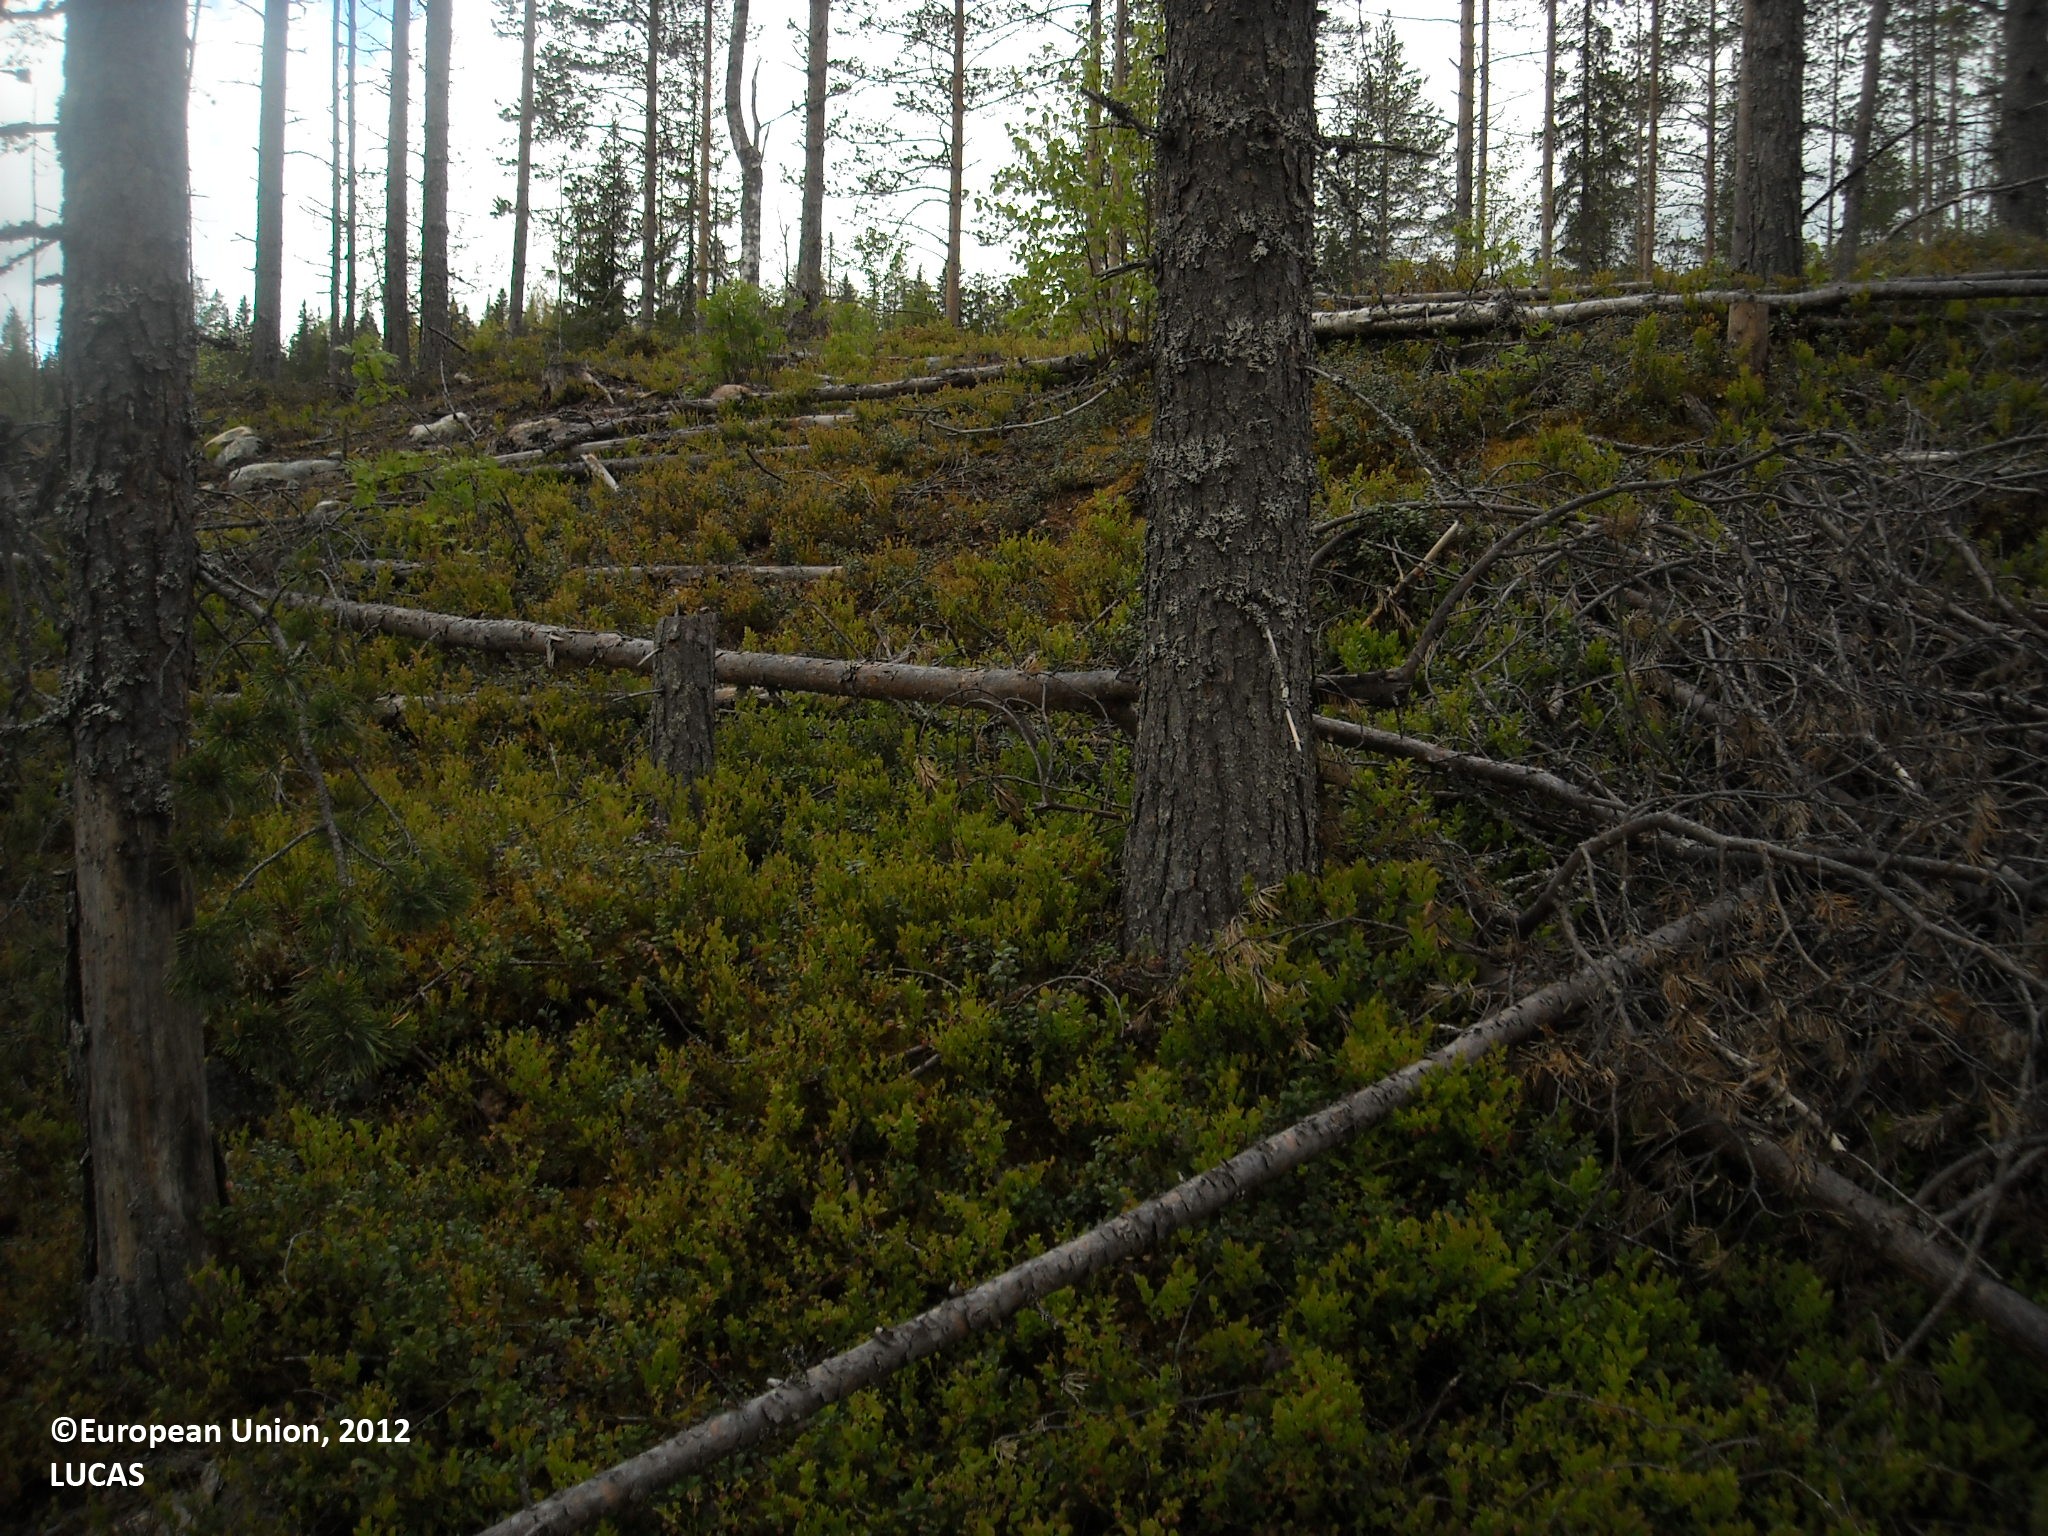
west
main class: Woodland
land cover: Pine dominated coniferous woodland
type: boreal forest
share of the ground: 50 - 75 %
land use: Forestry
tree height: > 5 m
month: June
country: FI
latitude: 65.1456
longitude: 27.9970
